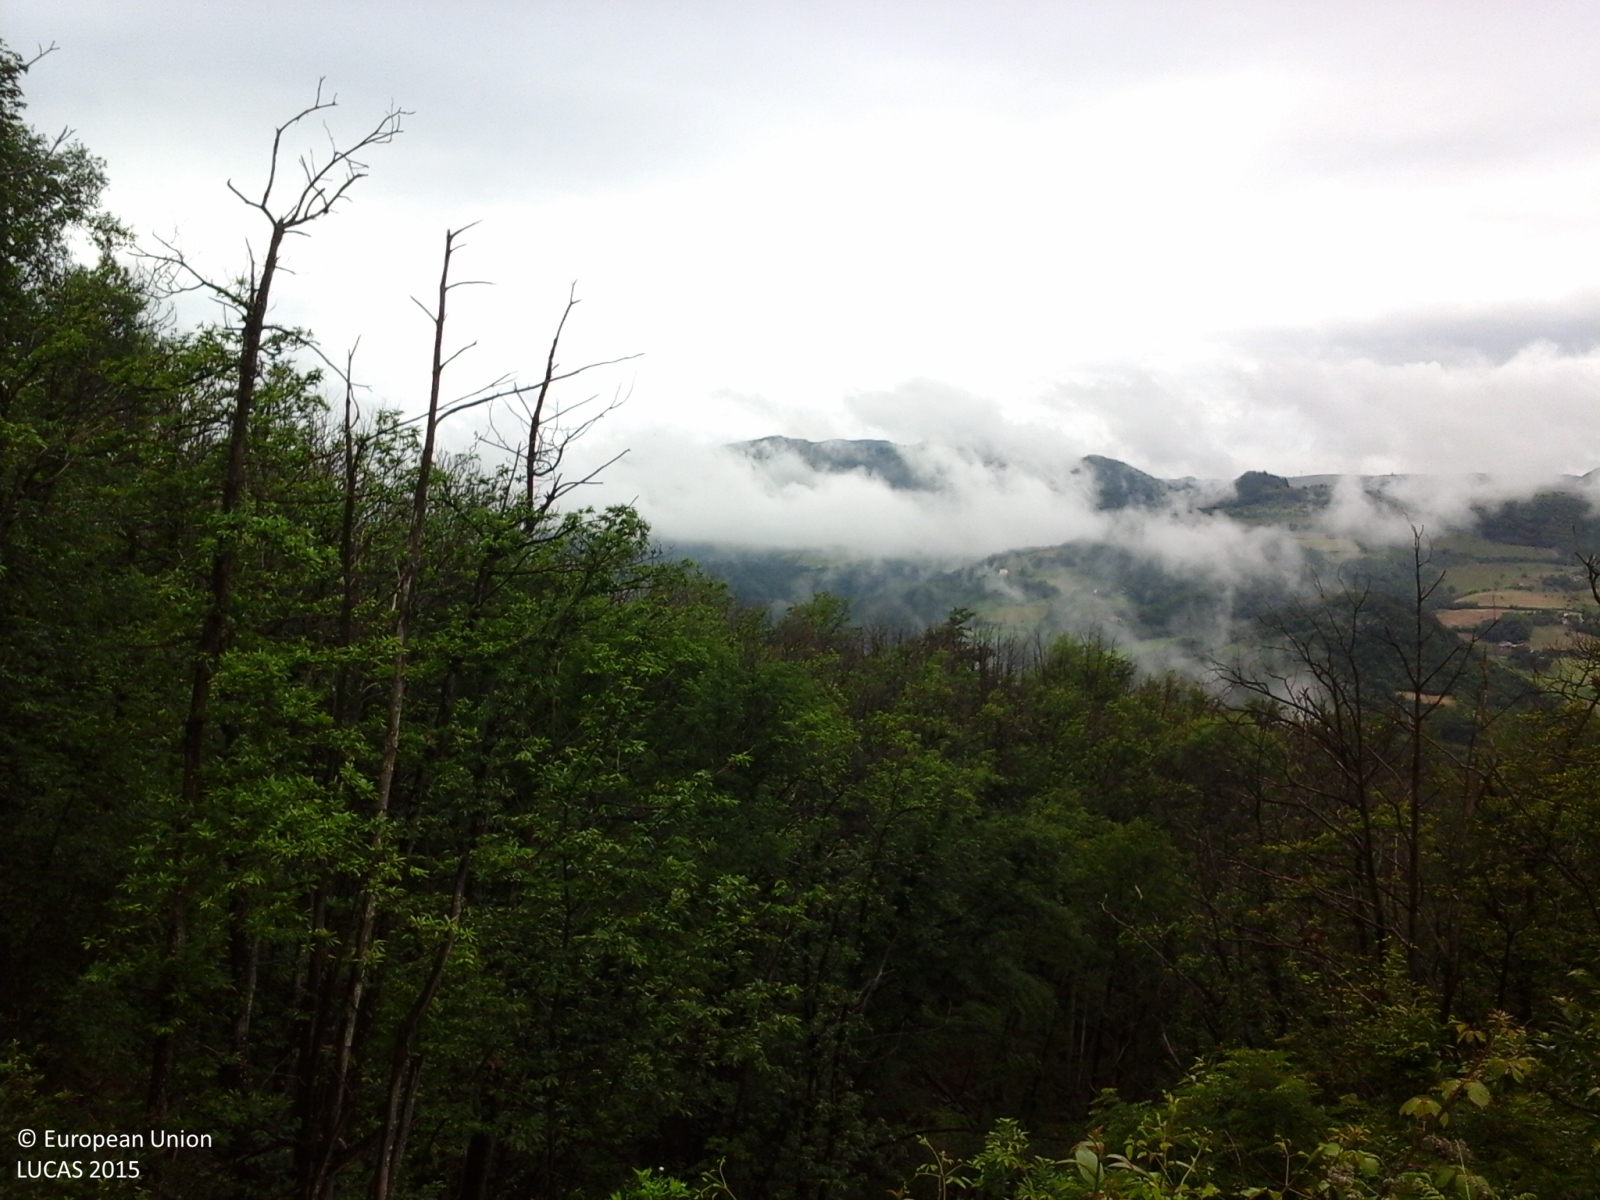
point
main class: Woodland
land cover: Broadleaved woodland
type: thermophilous deciduous forest
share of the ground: > 75 %
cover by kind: broadleaved forest trees 100 %
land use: Forestry
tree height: > 5 m
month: May
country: IT
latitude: 44.3077
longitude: 11.1882
